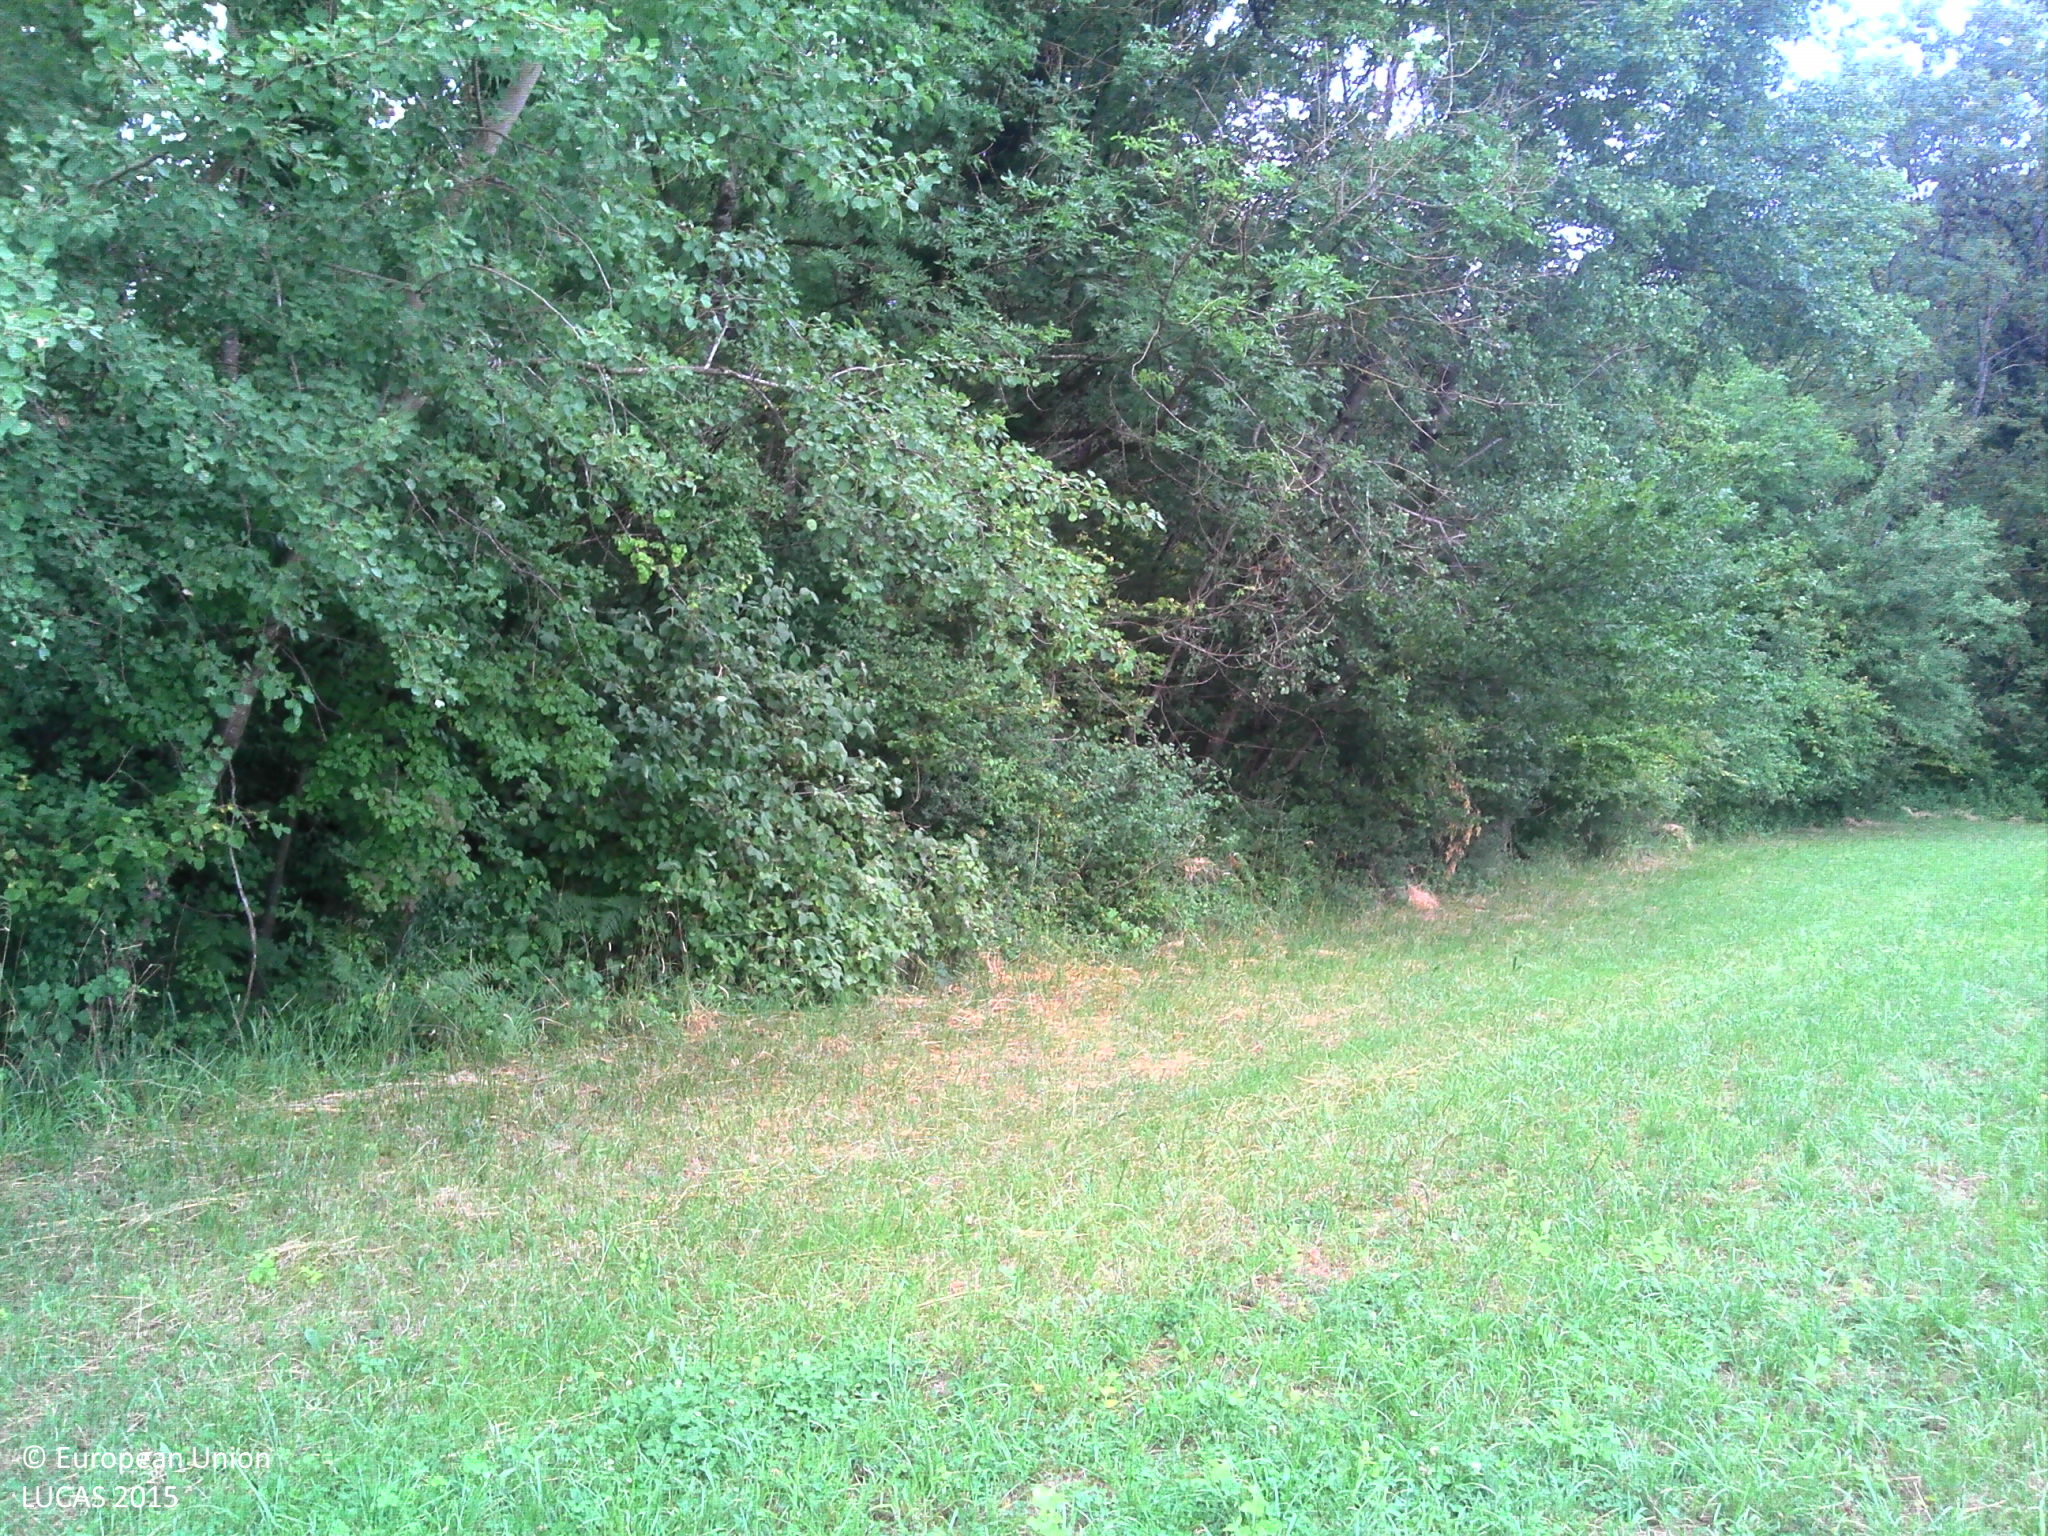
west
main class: Grassland
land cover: Grassland without tree/shrub cover
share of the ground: > 75 %
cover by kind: herbaceous plants 100 %
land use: Agriculture (excluding fallow land and kitchen gardens)
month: July
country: FR
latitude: 46.2514
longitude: 6.3066
